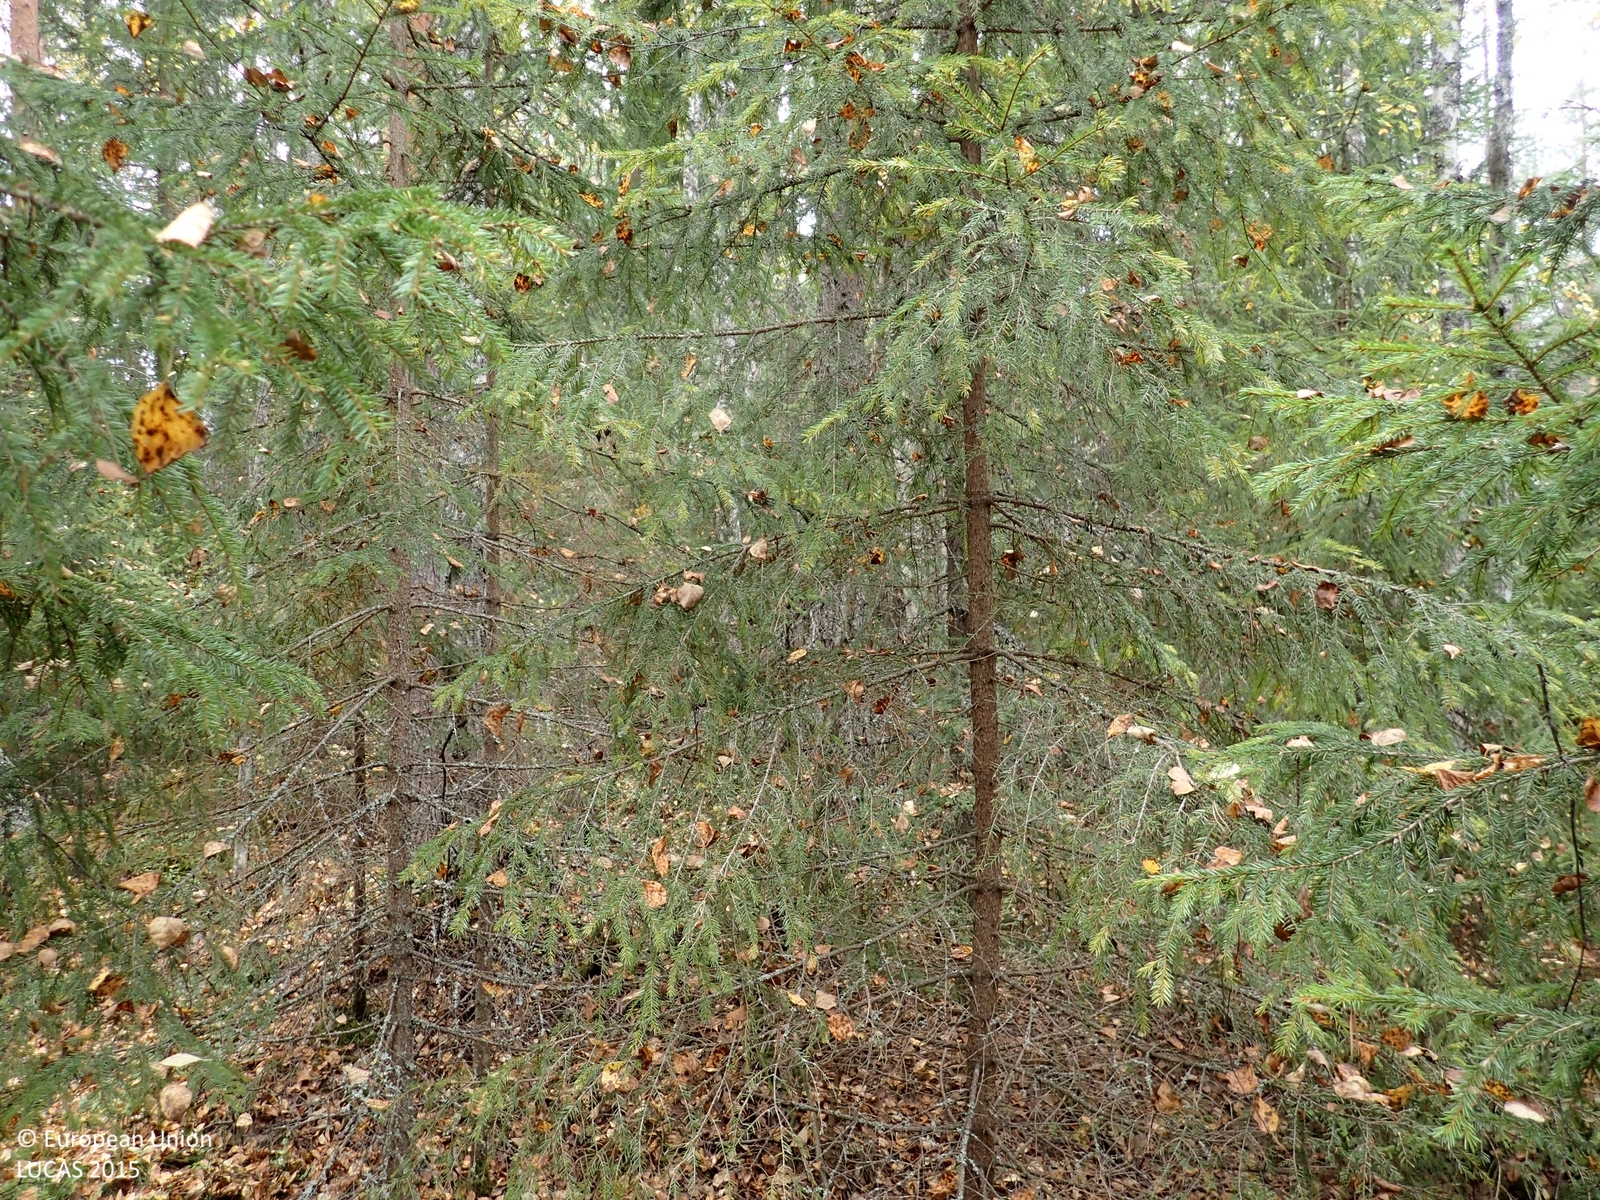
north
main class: Woodland
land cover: Other mixed woodland
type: boreal forest
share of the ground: > 75 %
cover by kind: coniferous forest trees 60 %, broadleaved forest trees 20 %, shrubs 10 %, herbaceous plants 5 %, lichens and mosses 5 %
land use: Forestry
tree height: > 5 m
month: September
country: FI
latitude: 63.0395
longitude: 25.6697
